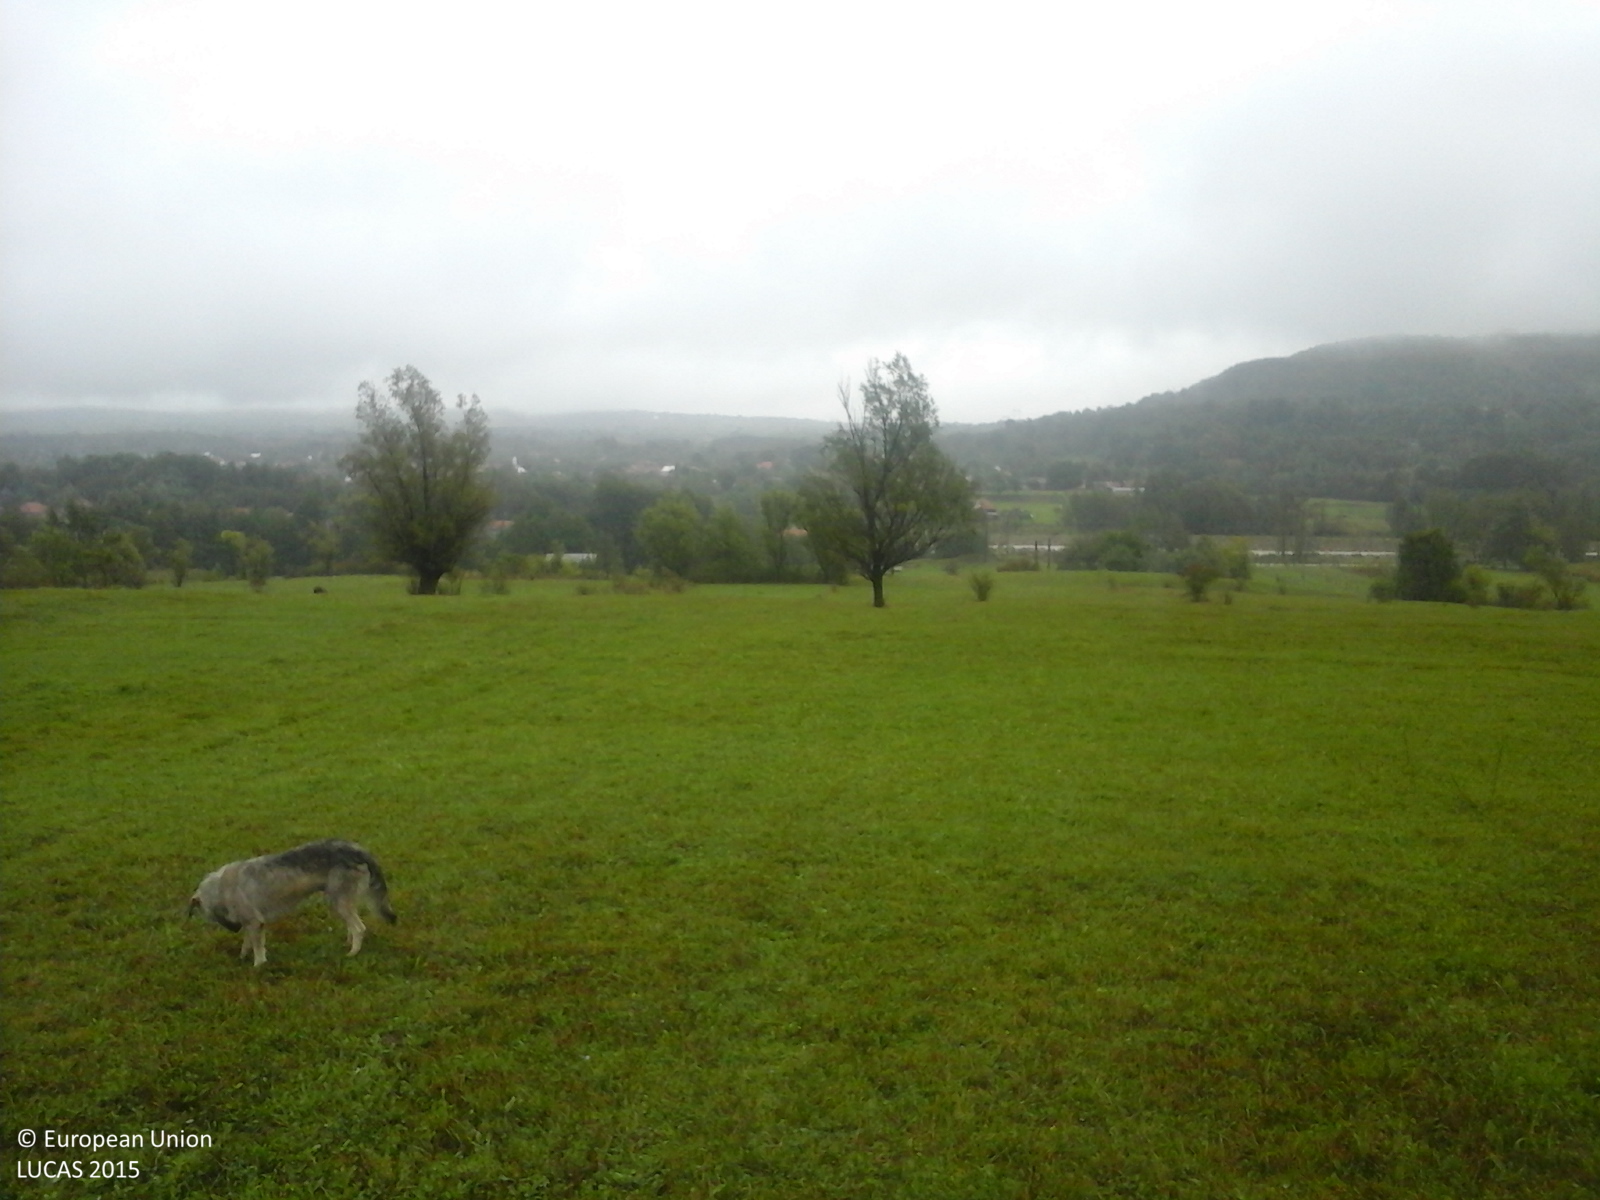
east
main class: Grassland
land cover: Grassland without tree/shrub cover
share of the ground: > 75 %
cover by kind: herbaceous plants 100 %
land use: Agriculture (excluding fallow land and kitchen gardens)
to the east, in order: Grassland without tree/shrub cover; Single bushes/trees; Grassland without tree/shrub cover; Abandoned hedges; Tracks; Abandoned hedges; Fences; Vineyards; Fences; Abandoned hedges; Grassland without tree/shrub cover
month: September
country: RO
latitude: 45.1451
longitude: 23.6307
